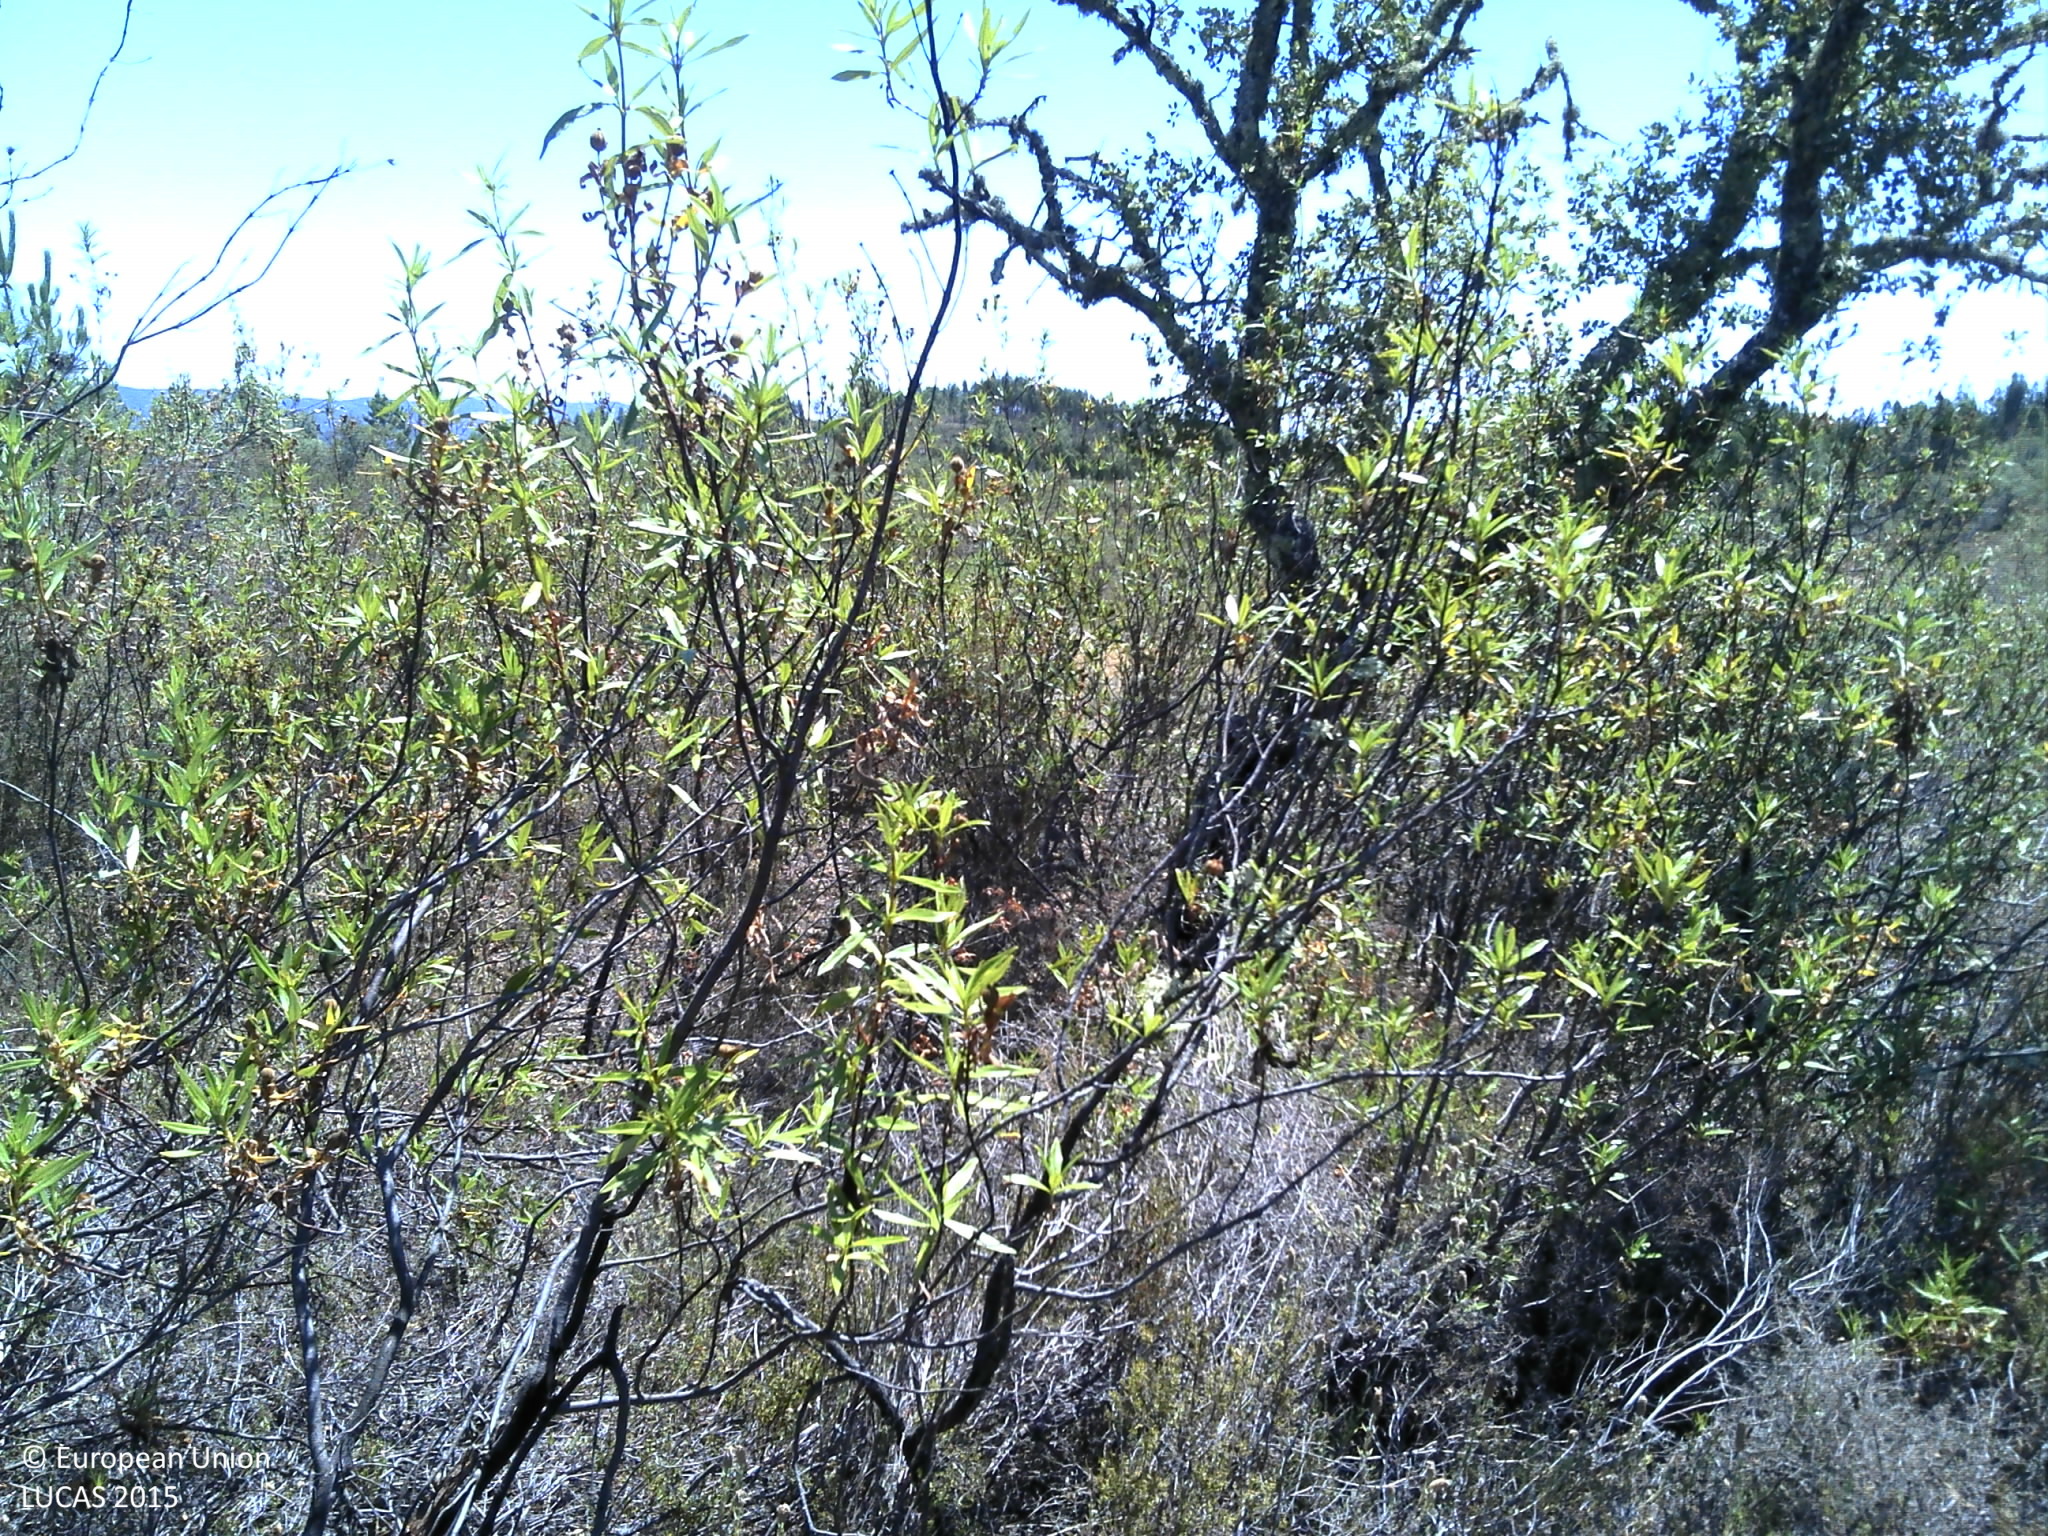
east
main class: Shrubland
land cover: Shrubland with sparse tree cover
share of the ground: > 75 %
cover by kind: shrubs 95 %, broadleaved forest trees 5 %
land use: Semi-natural and natural areas not in use
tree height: < 5 m
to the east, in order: Shrubland with sparse tree cover; Broadleaved woodland; Shrubland with sparse tree cover; Tracks; Shrubland with sparse tree cover; Tracks; Shrubland with sparse tree cover; Olive groves
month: July
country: PT
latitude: 39.6753
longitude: -7.8132
